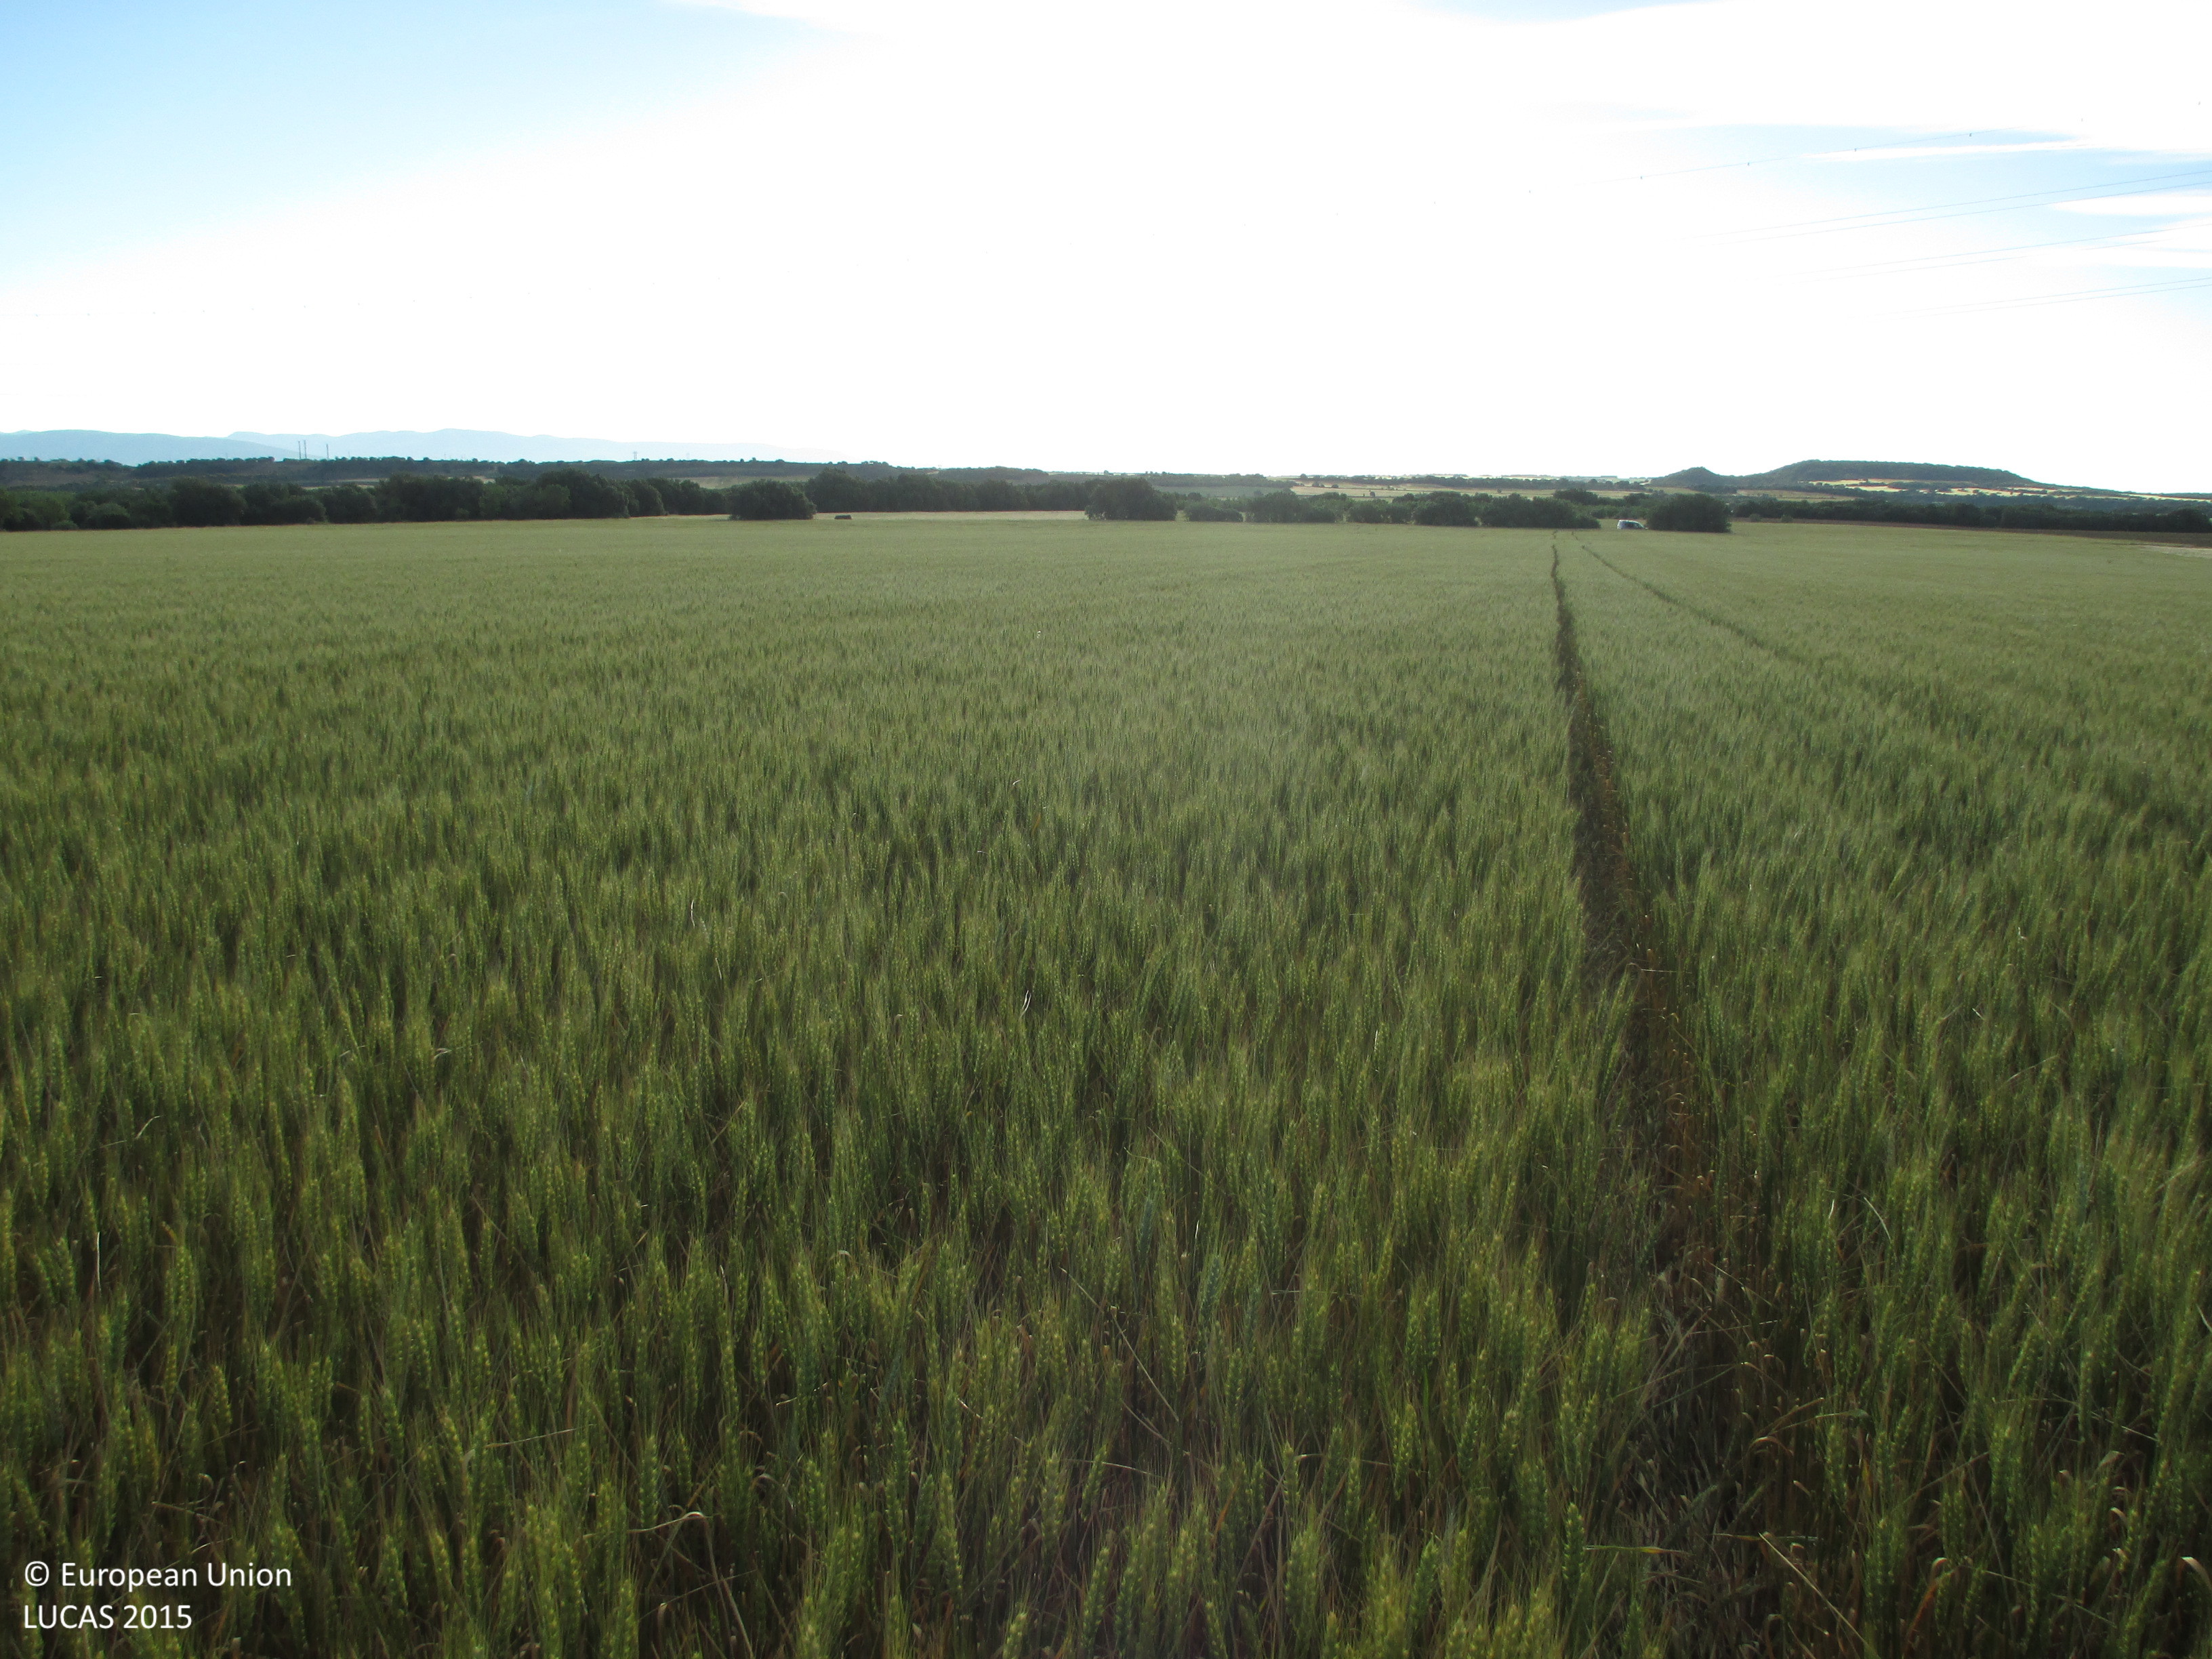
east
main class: Cropland
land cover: Common wheat
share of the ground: > 75 %
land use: Agriculture (excluding fallow land and kitchen gardens)
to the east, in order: Common wheat; Electric lines; Common wheat; Lines of trees; Grass margins; Tracks; Single bushes/trees; Grass margins; Common wheat
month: May
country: ES
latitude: 42.1080
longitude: -0.3130
